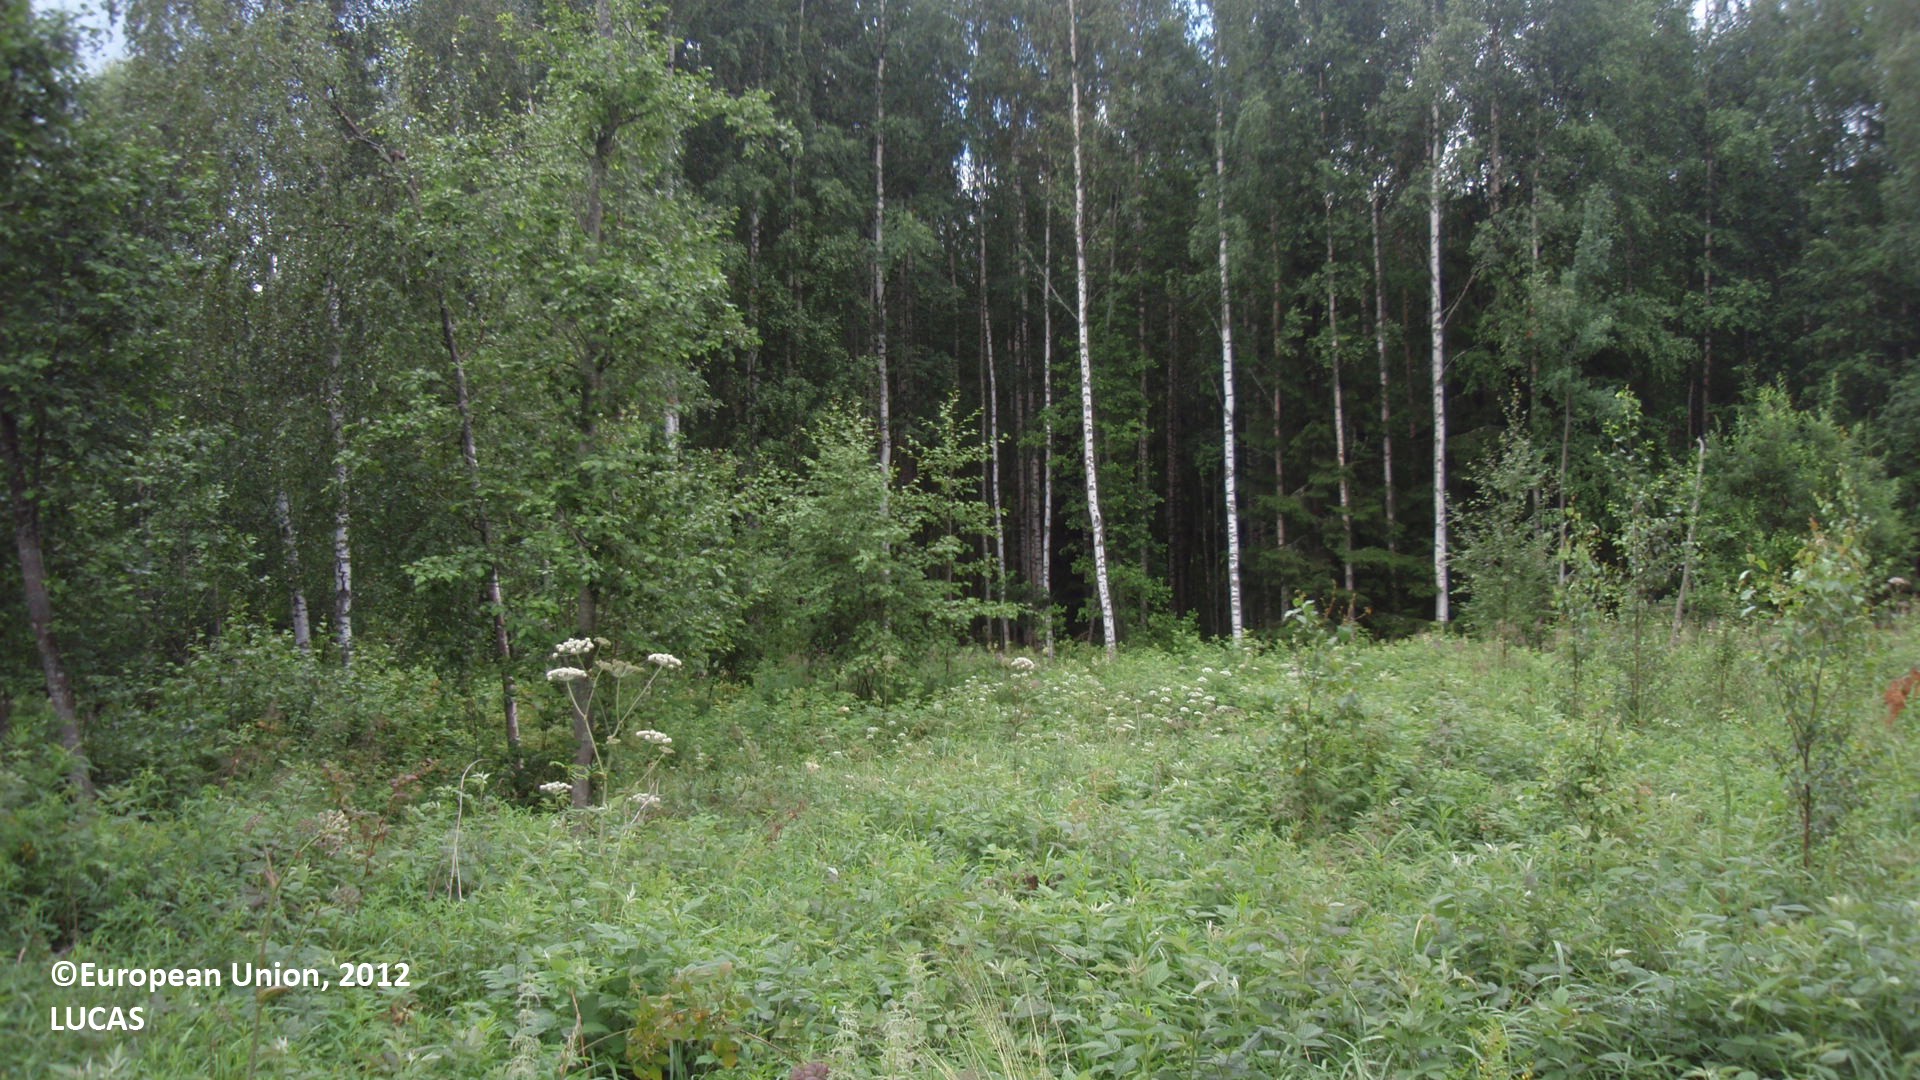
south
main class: Shrubland
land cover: Shrubland with sparse tree cover
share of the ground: > 75 %
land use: Fallow land
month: July
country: FI
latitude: 61.1521
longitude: 28.6327
